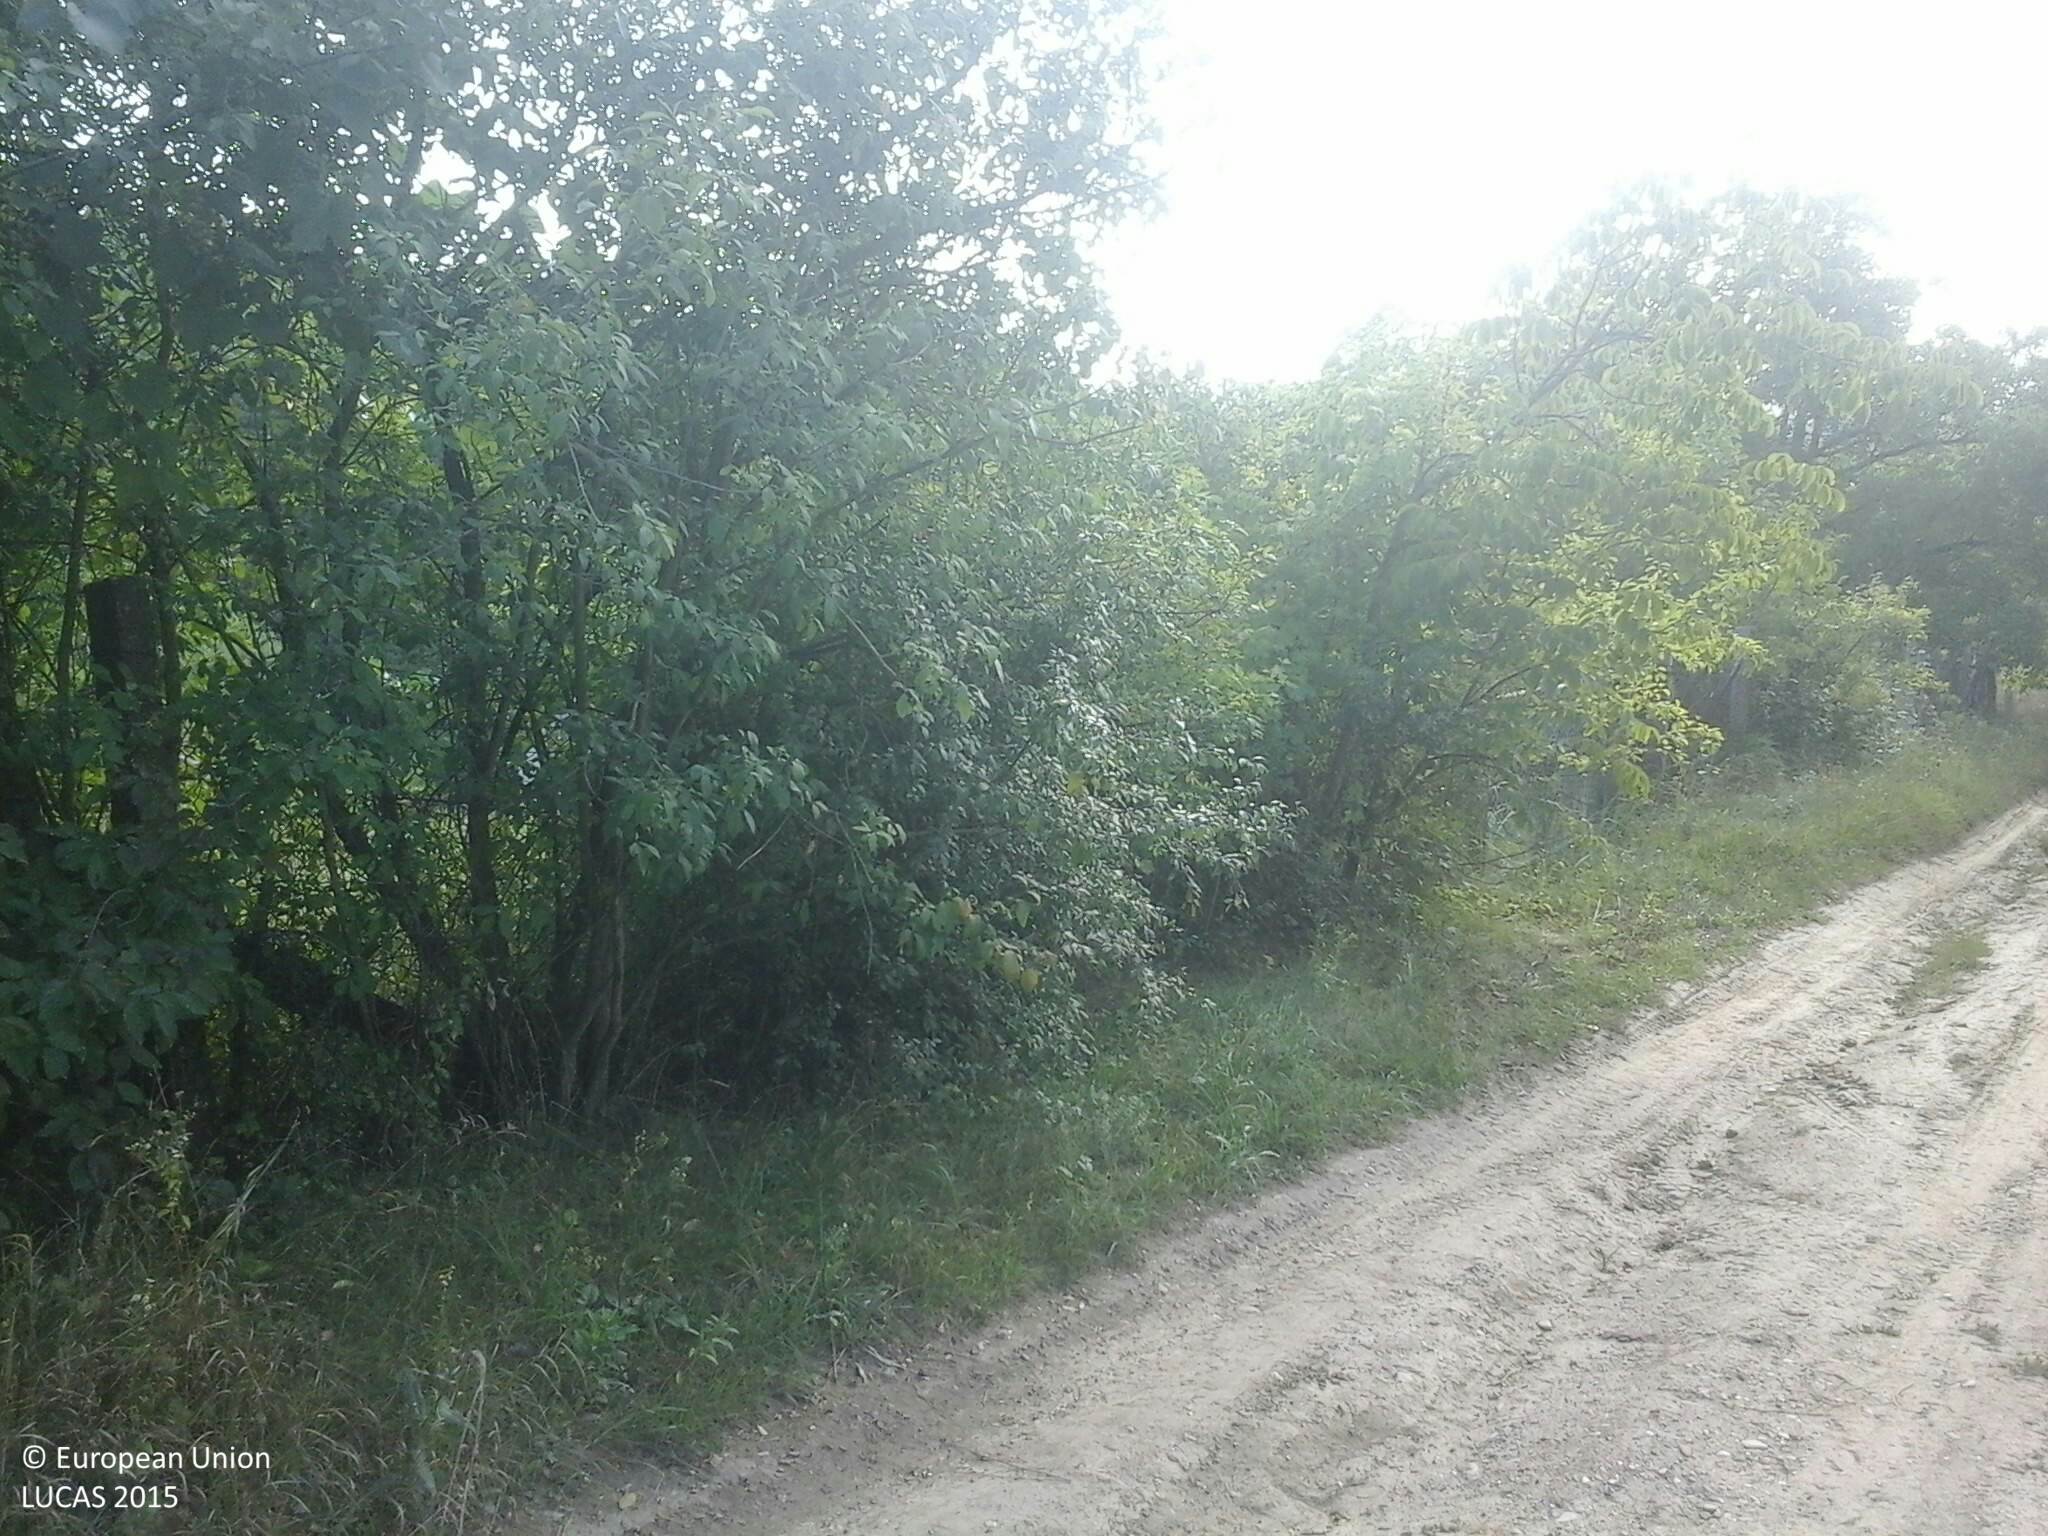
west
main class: Grassland
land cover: Spontaneously vegetated surfaces
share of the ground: > 75 %
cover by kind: herbaceous plants 100 %
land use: Residential
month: August
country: HU
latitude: 48.0254
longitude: 19.3414
